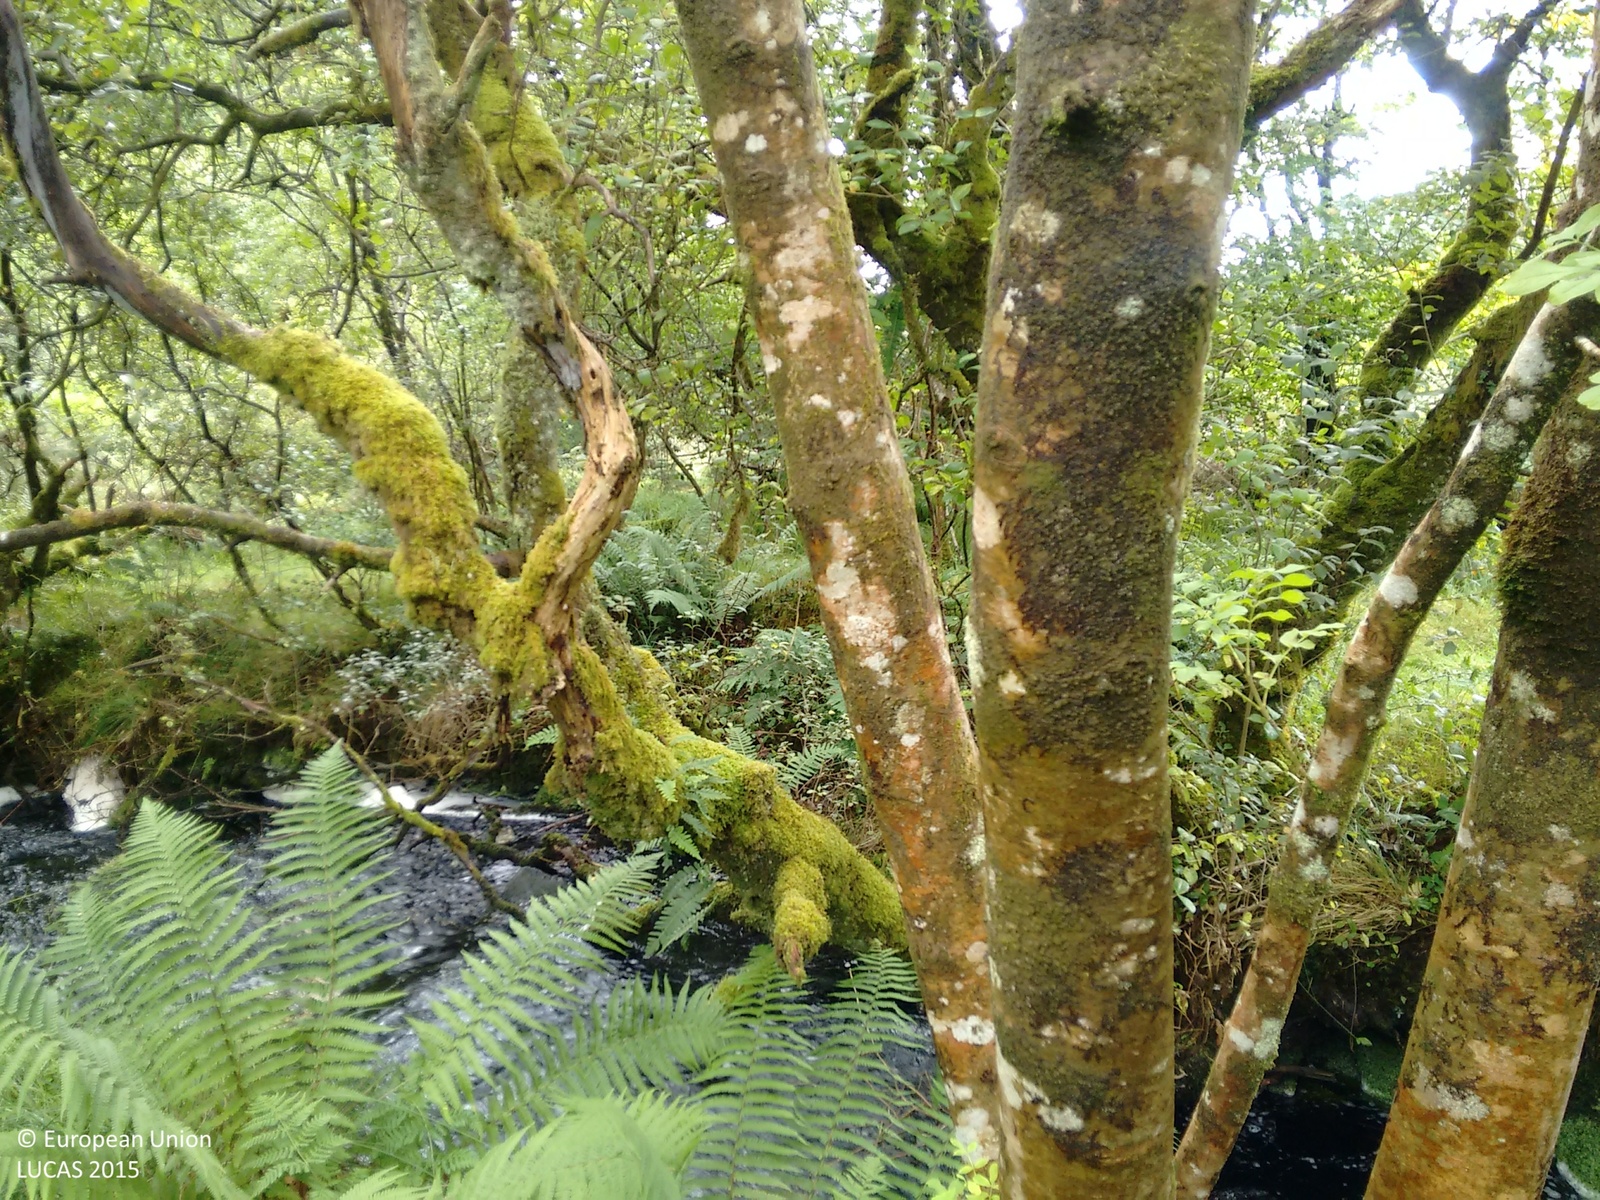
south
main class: Shrubland
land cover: Shrubland with sparse tree cover
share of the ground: > 75 %
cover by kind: shrubs 80 %, herbaceous plants 15 %, coniferous forest trees 5 %
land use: Forestry
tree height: < 5 m
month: September
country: IE
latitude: 52.9288
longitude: -8.7848
